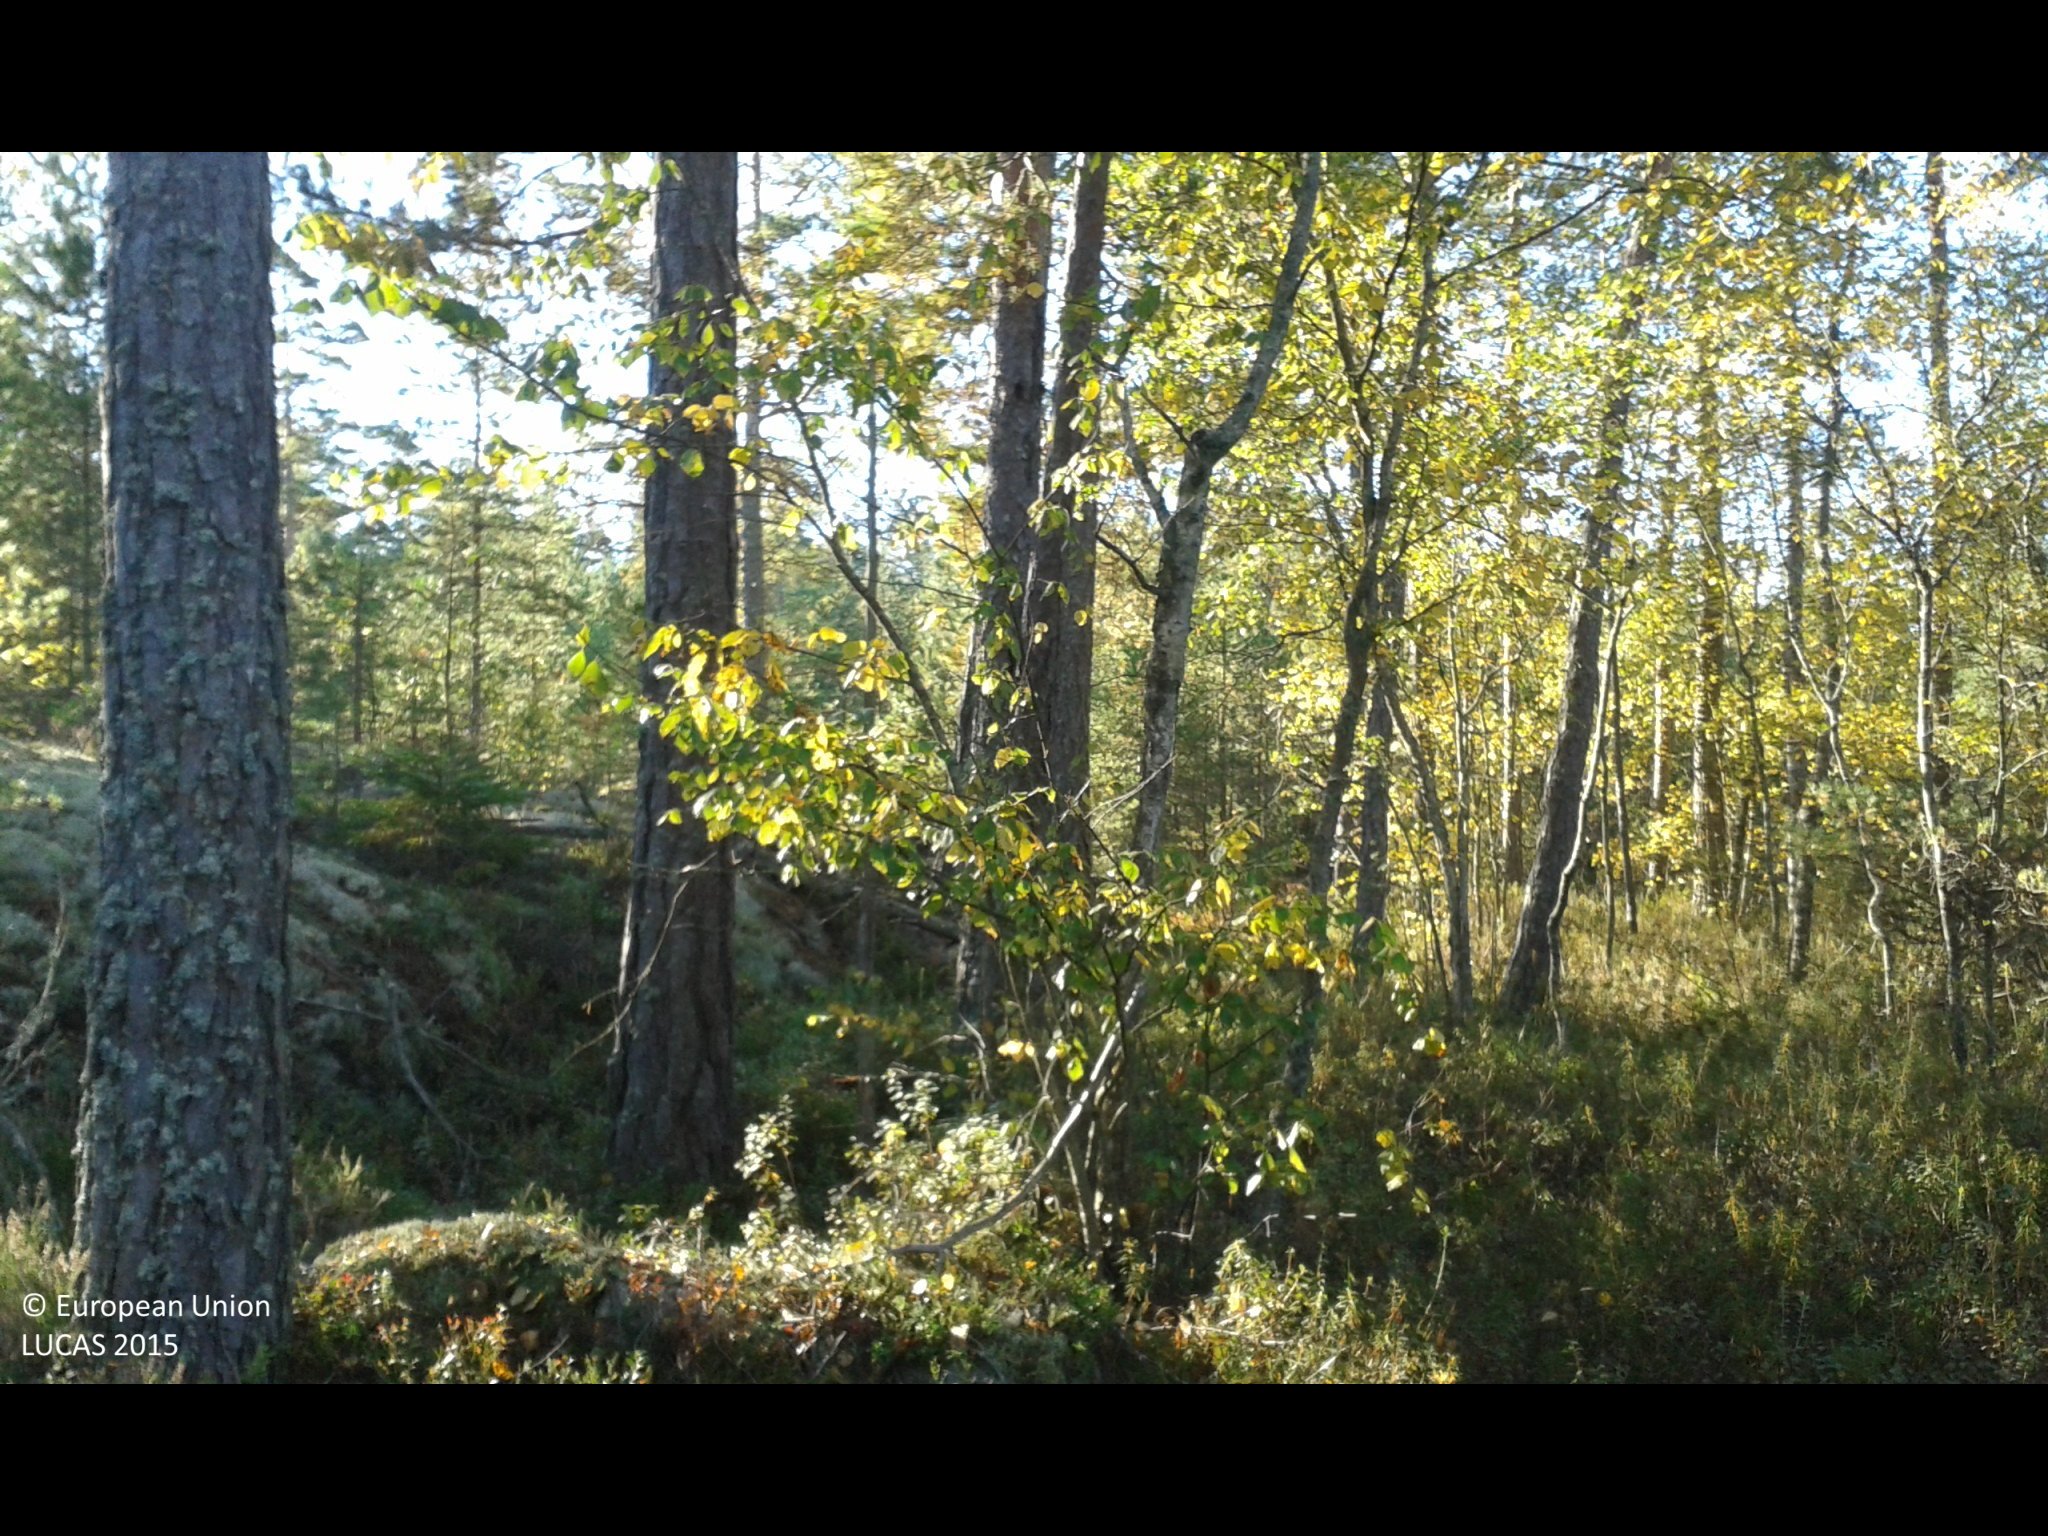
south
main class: Woodland
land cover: Pine dominated mixed woodland
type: hemiboreal forest and nemoral coniferous forest and mixed broadleaved-coniferous forest
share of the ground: 50 - 75 %
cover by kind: coniferous forest trees 35 %, broadleaved forest trees 35 %, herbaceous plants 30 %
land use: Forestry
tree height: > 5 m
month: September
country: SE
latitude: 59.0795
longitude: 17.4472
